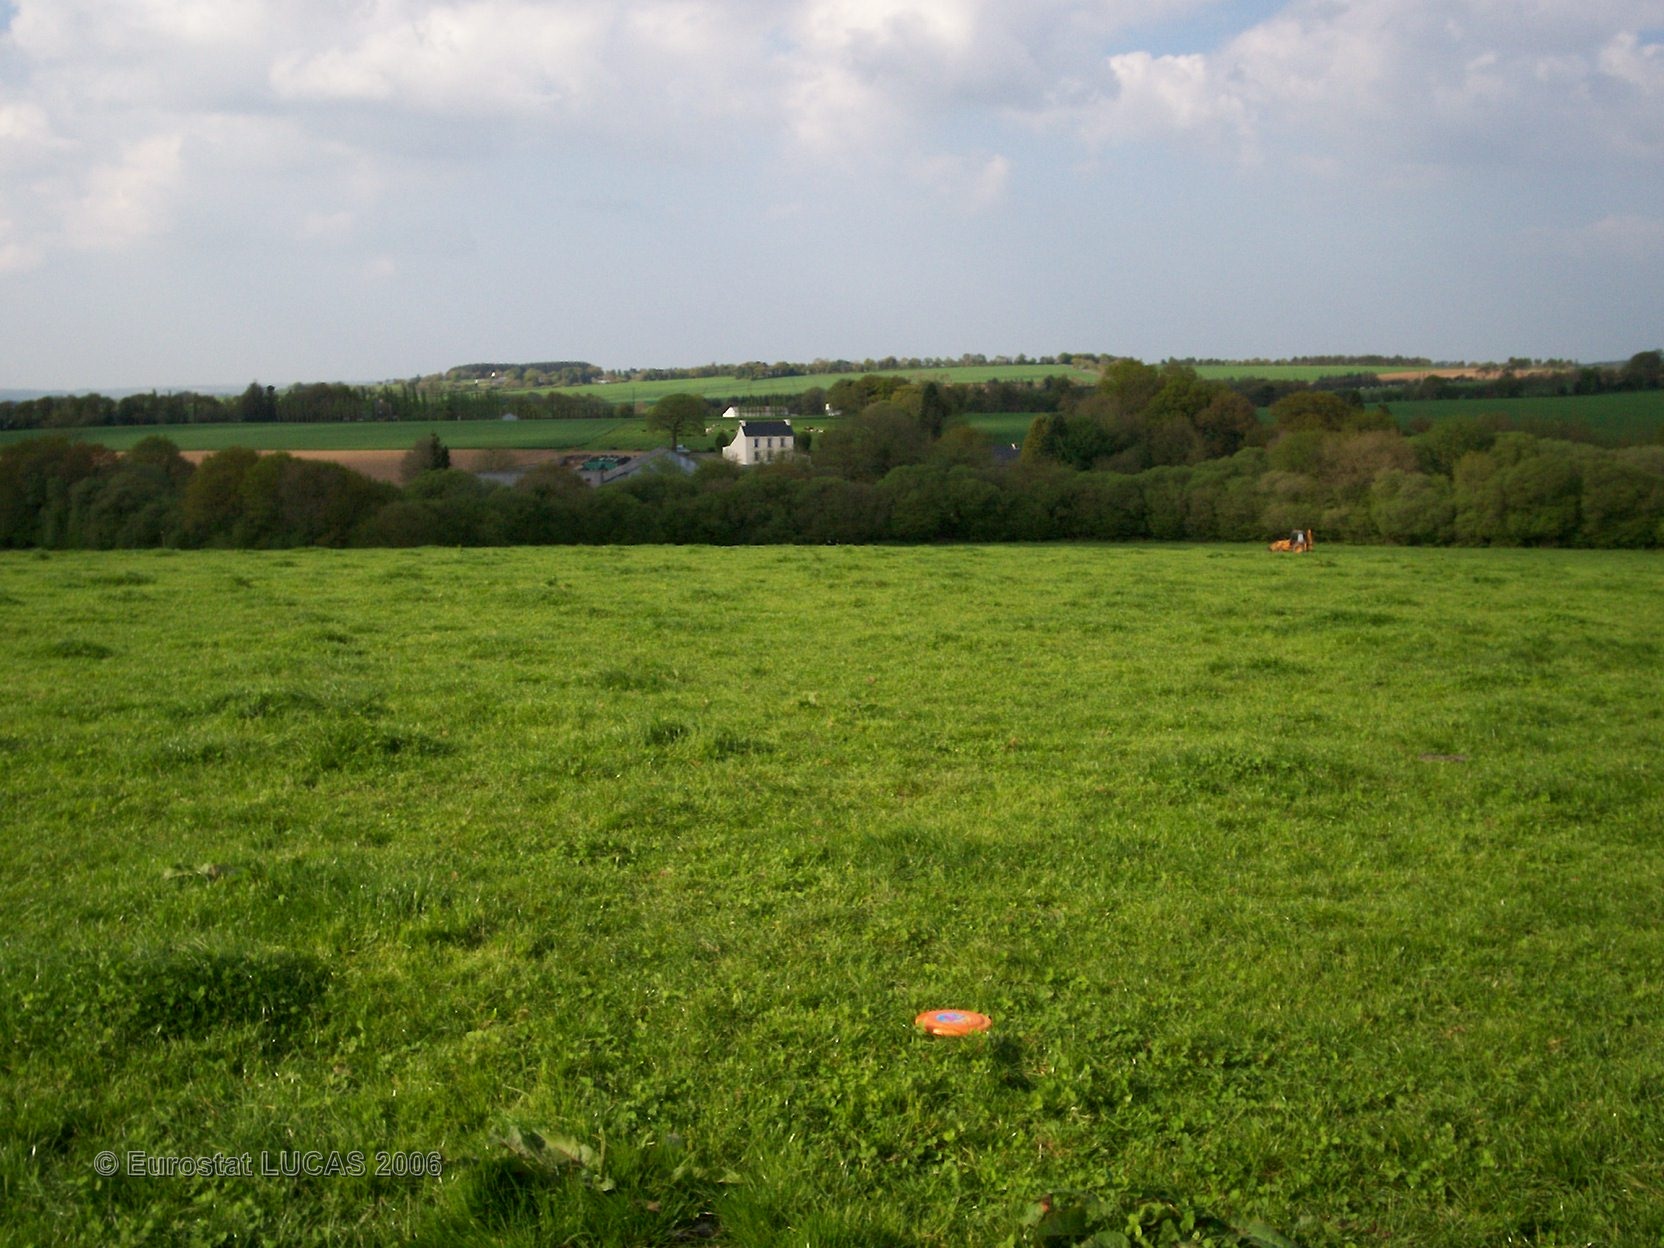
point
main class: Grassland
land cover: Grassland without tree/shrub cover
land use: Agriculture (excluding fallow land and kitchen gardens)
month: May
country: FR
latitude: 48.3413
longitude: -3.6125
